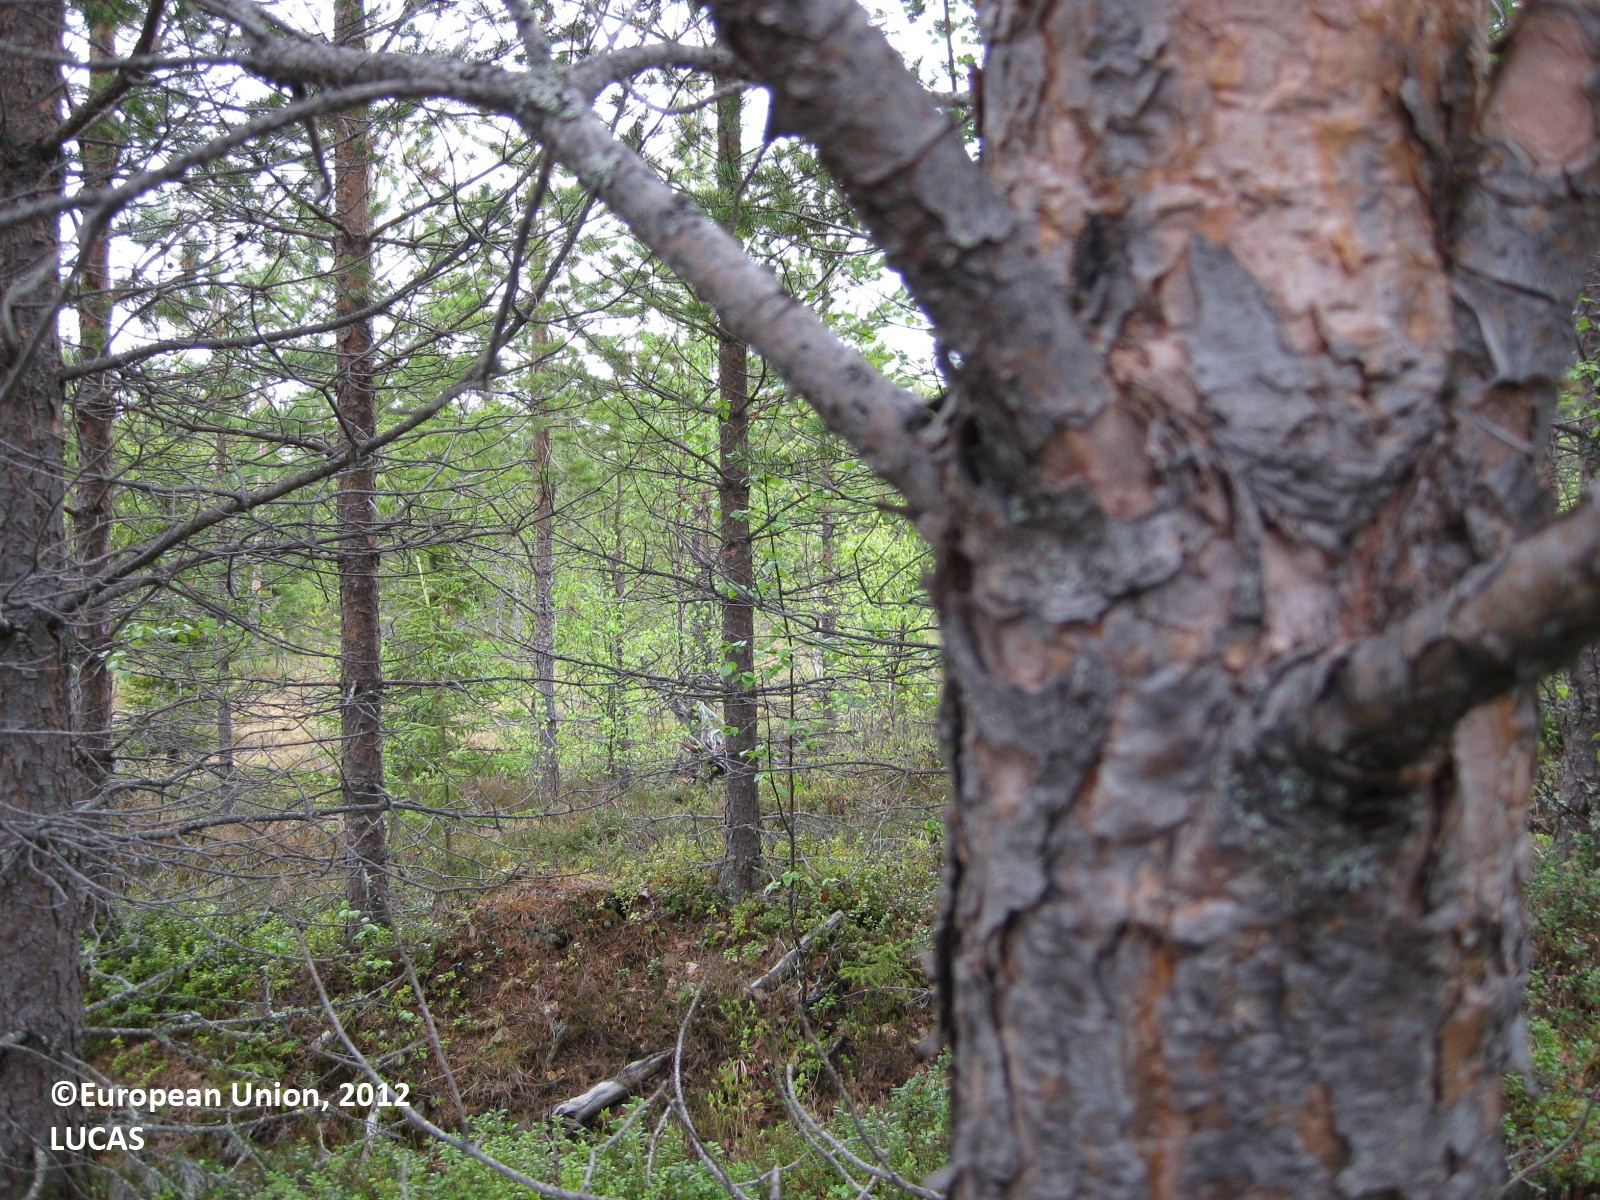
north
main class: Woodland
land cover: Pine dominated coniferous woodland
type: boreal forest
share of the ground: > 75 %
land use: Forestry
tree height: > 5 m
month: June
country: FI
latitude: 65.2637
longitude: 29.2322
